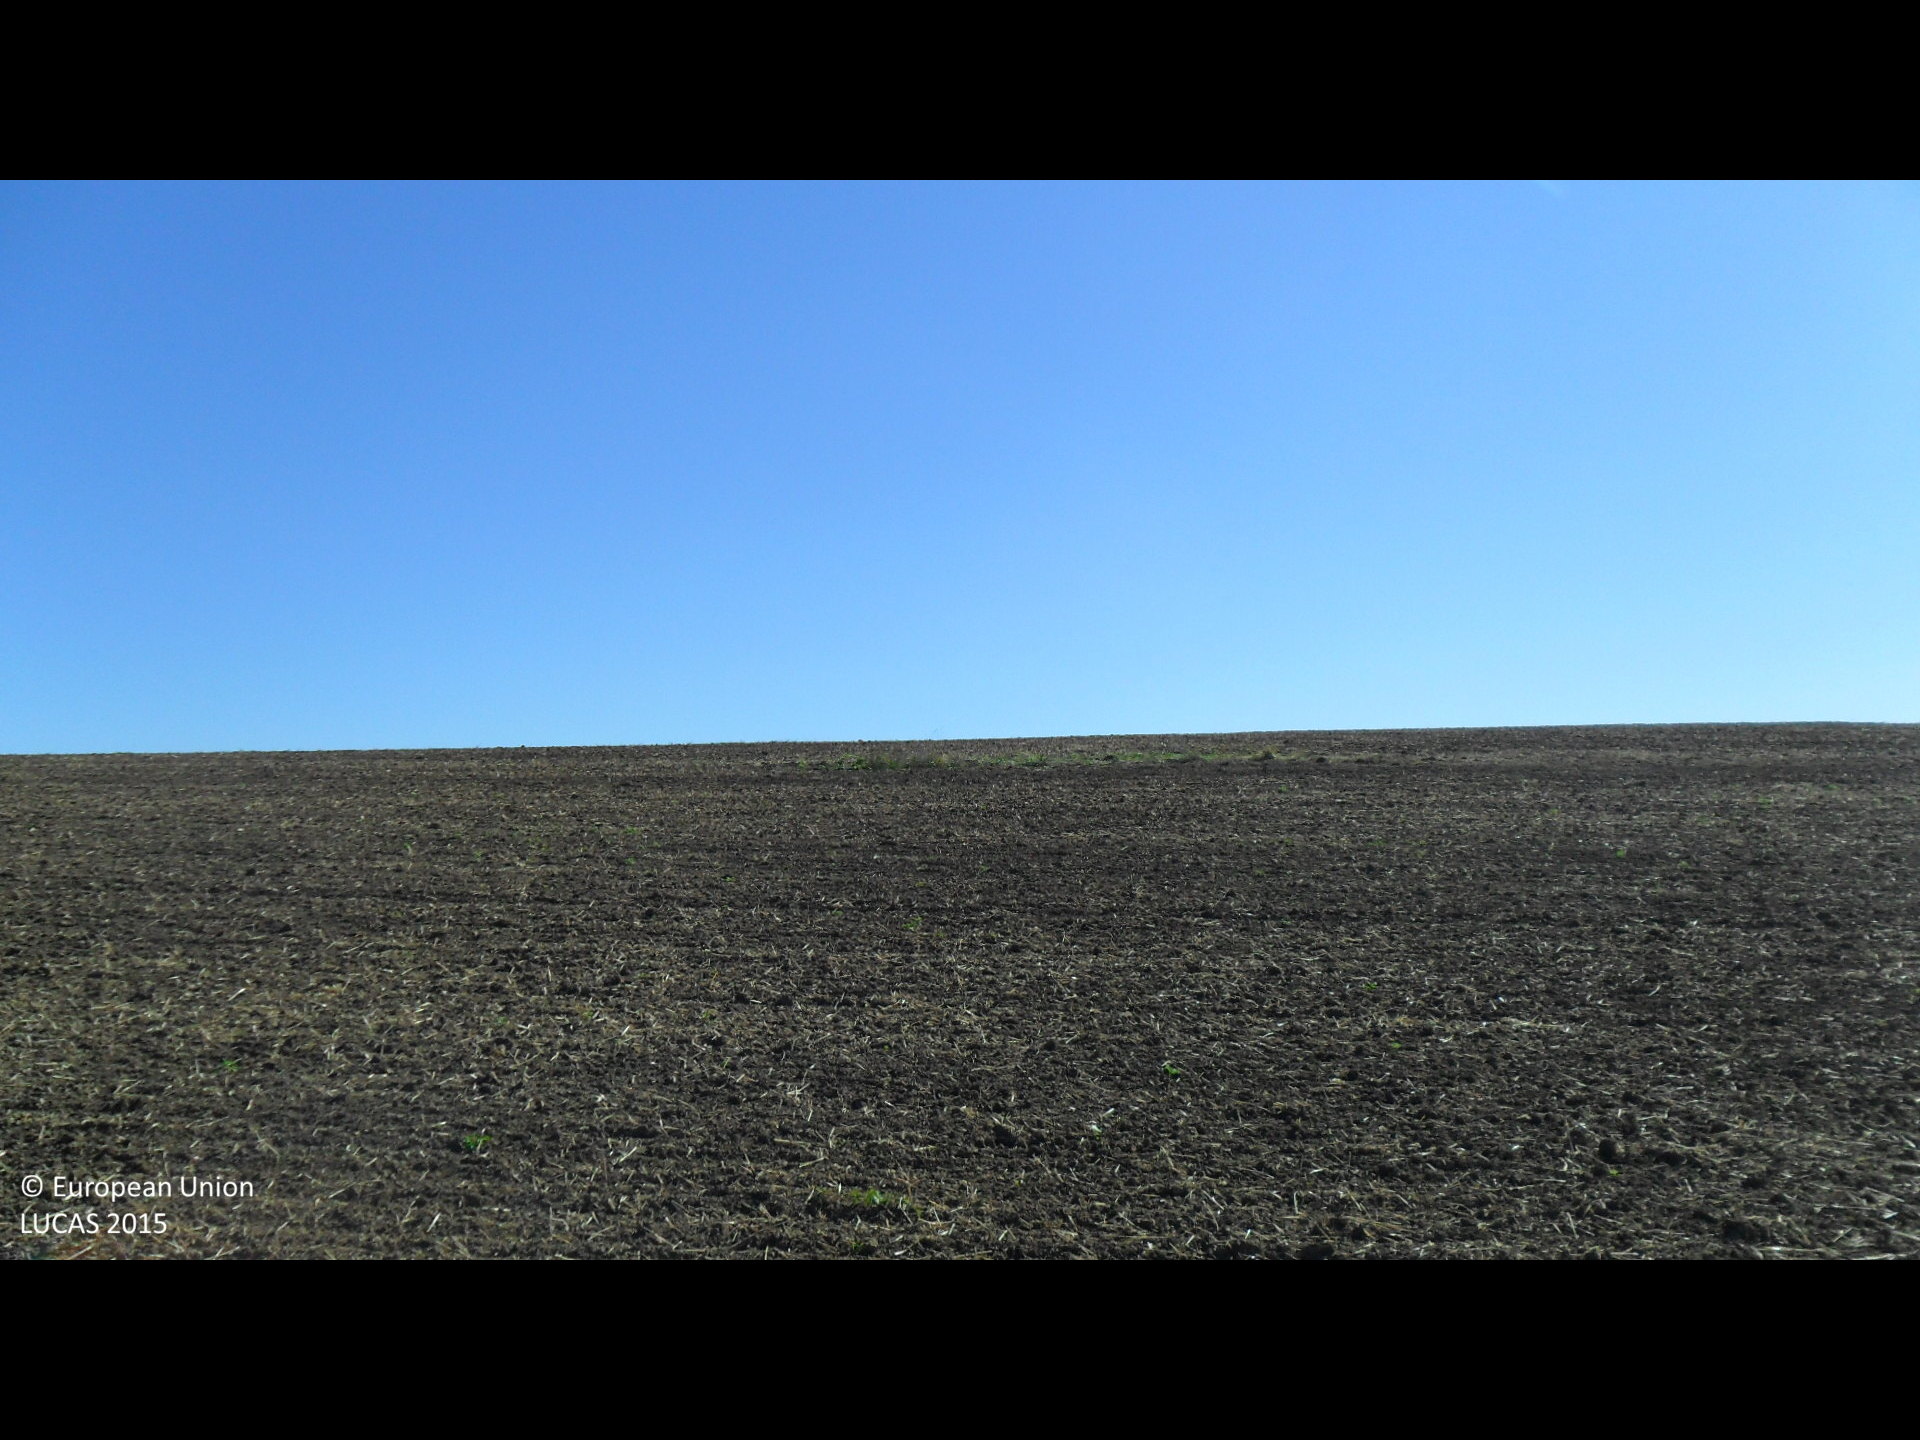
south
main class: Cropland
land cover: Common wheat
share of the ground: < 10 %
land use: Agriculture (excluding fallow land and kitchen gardens)
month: September
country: BG
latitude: 43.1351
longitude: 26.4623
